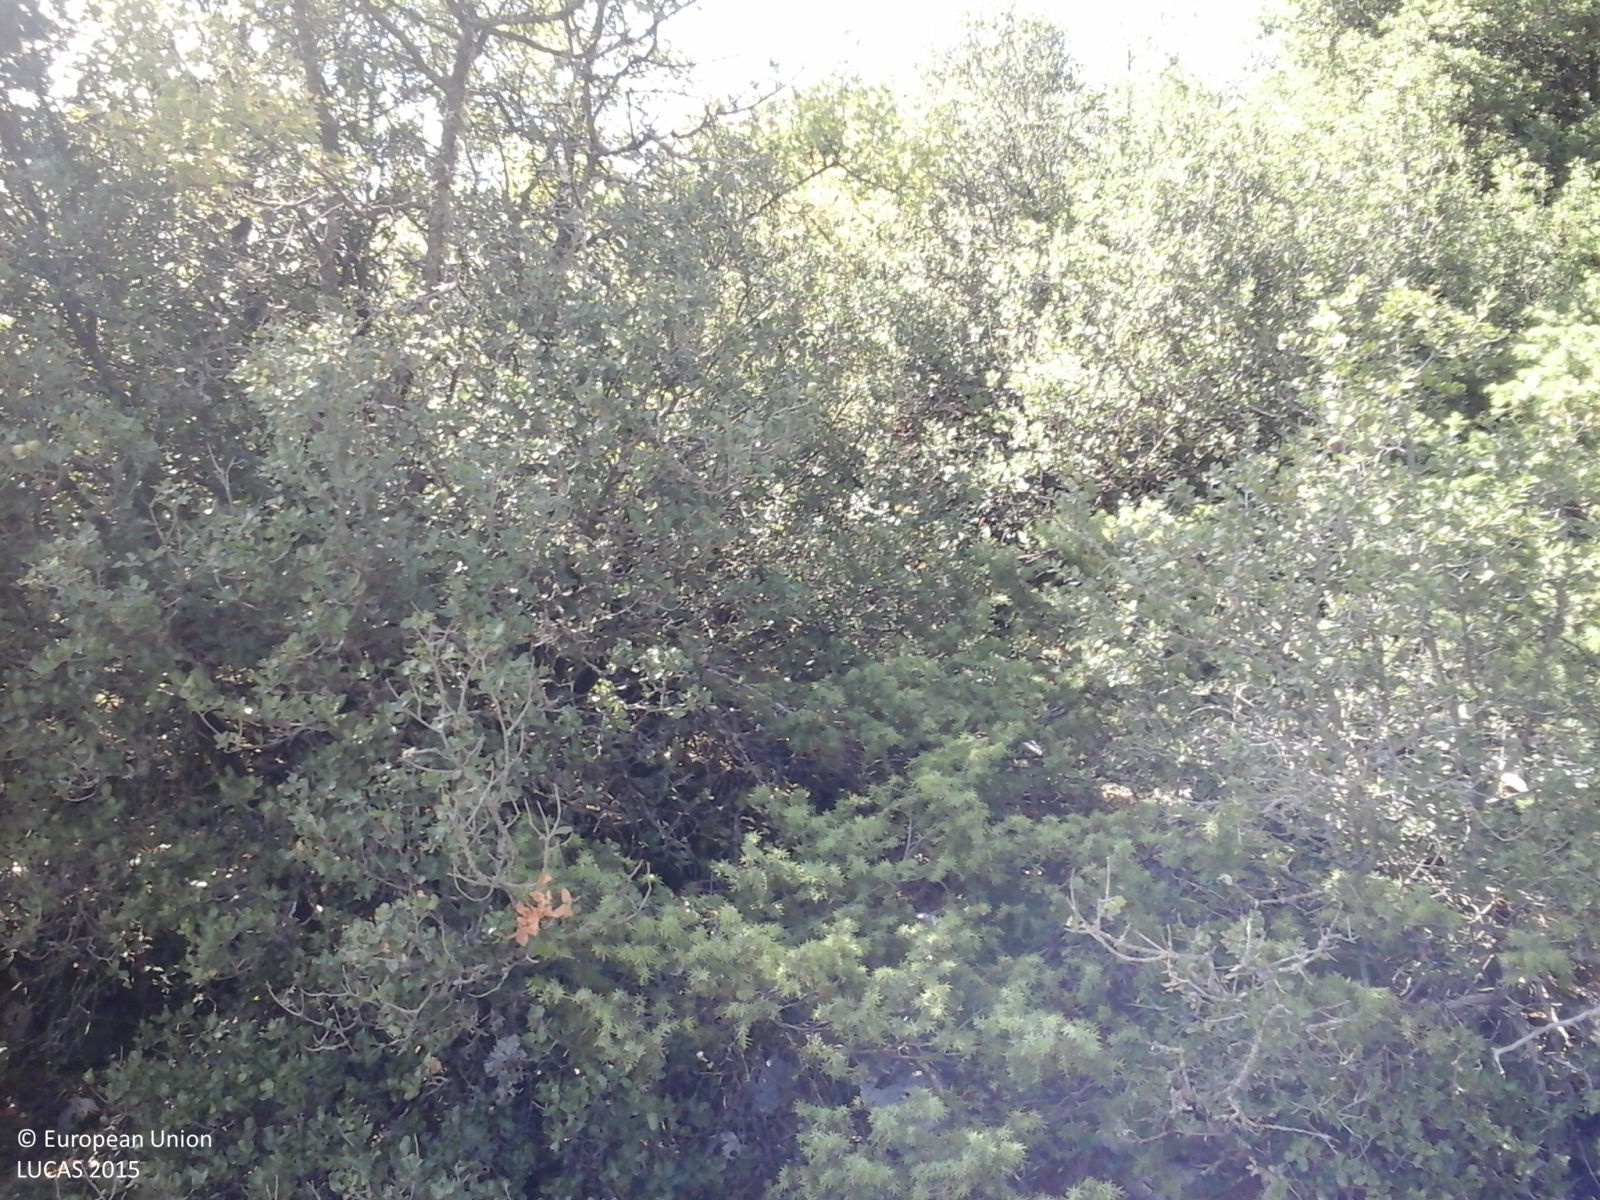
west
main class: Shrubland
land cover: Shrubland with sparse tree cover
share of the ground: > 75 %
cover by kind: shrubs 90 %, broadleaved forest trees 5 %, herbaceous plants 5 %
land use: Semi-natural and natural areas not in use
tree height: < 5 m
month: September
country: GR
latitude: 39.8808
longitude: 20.7023
